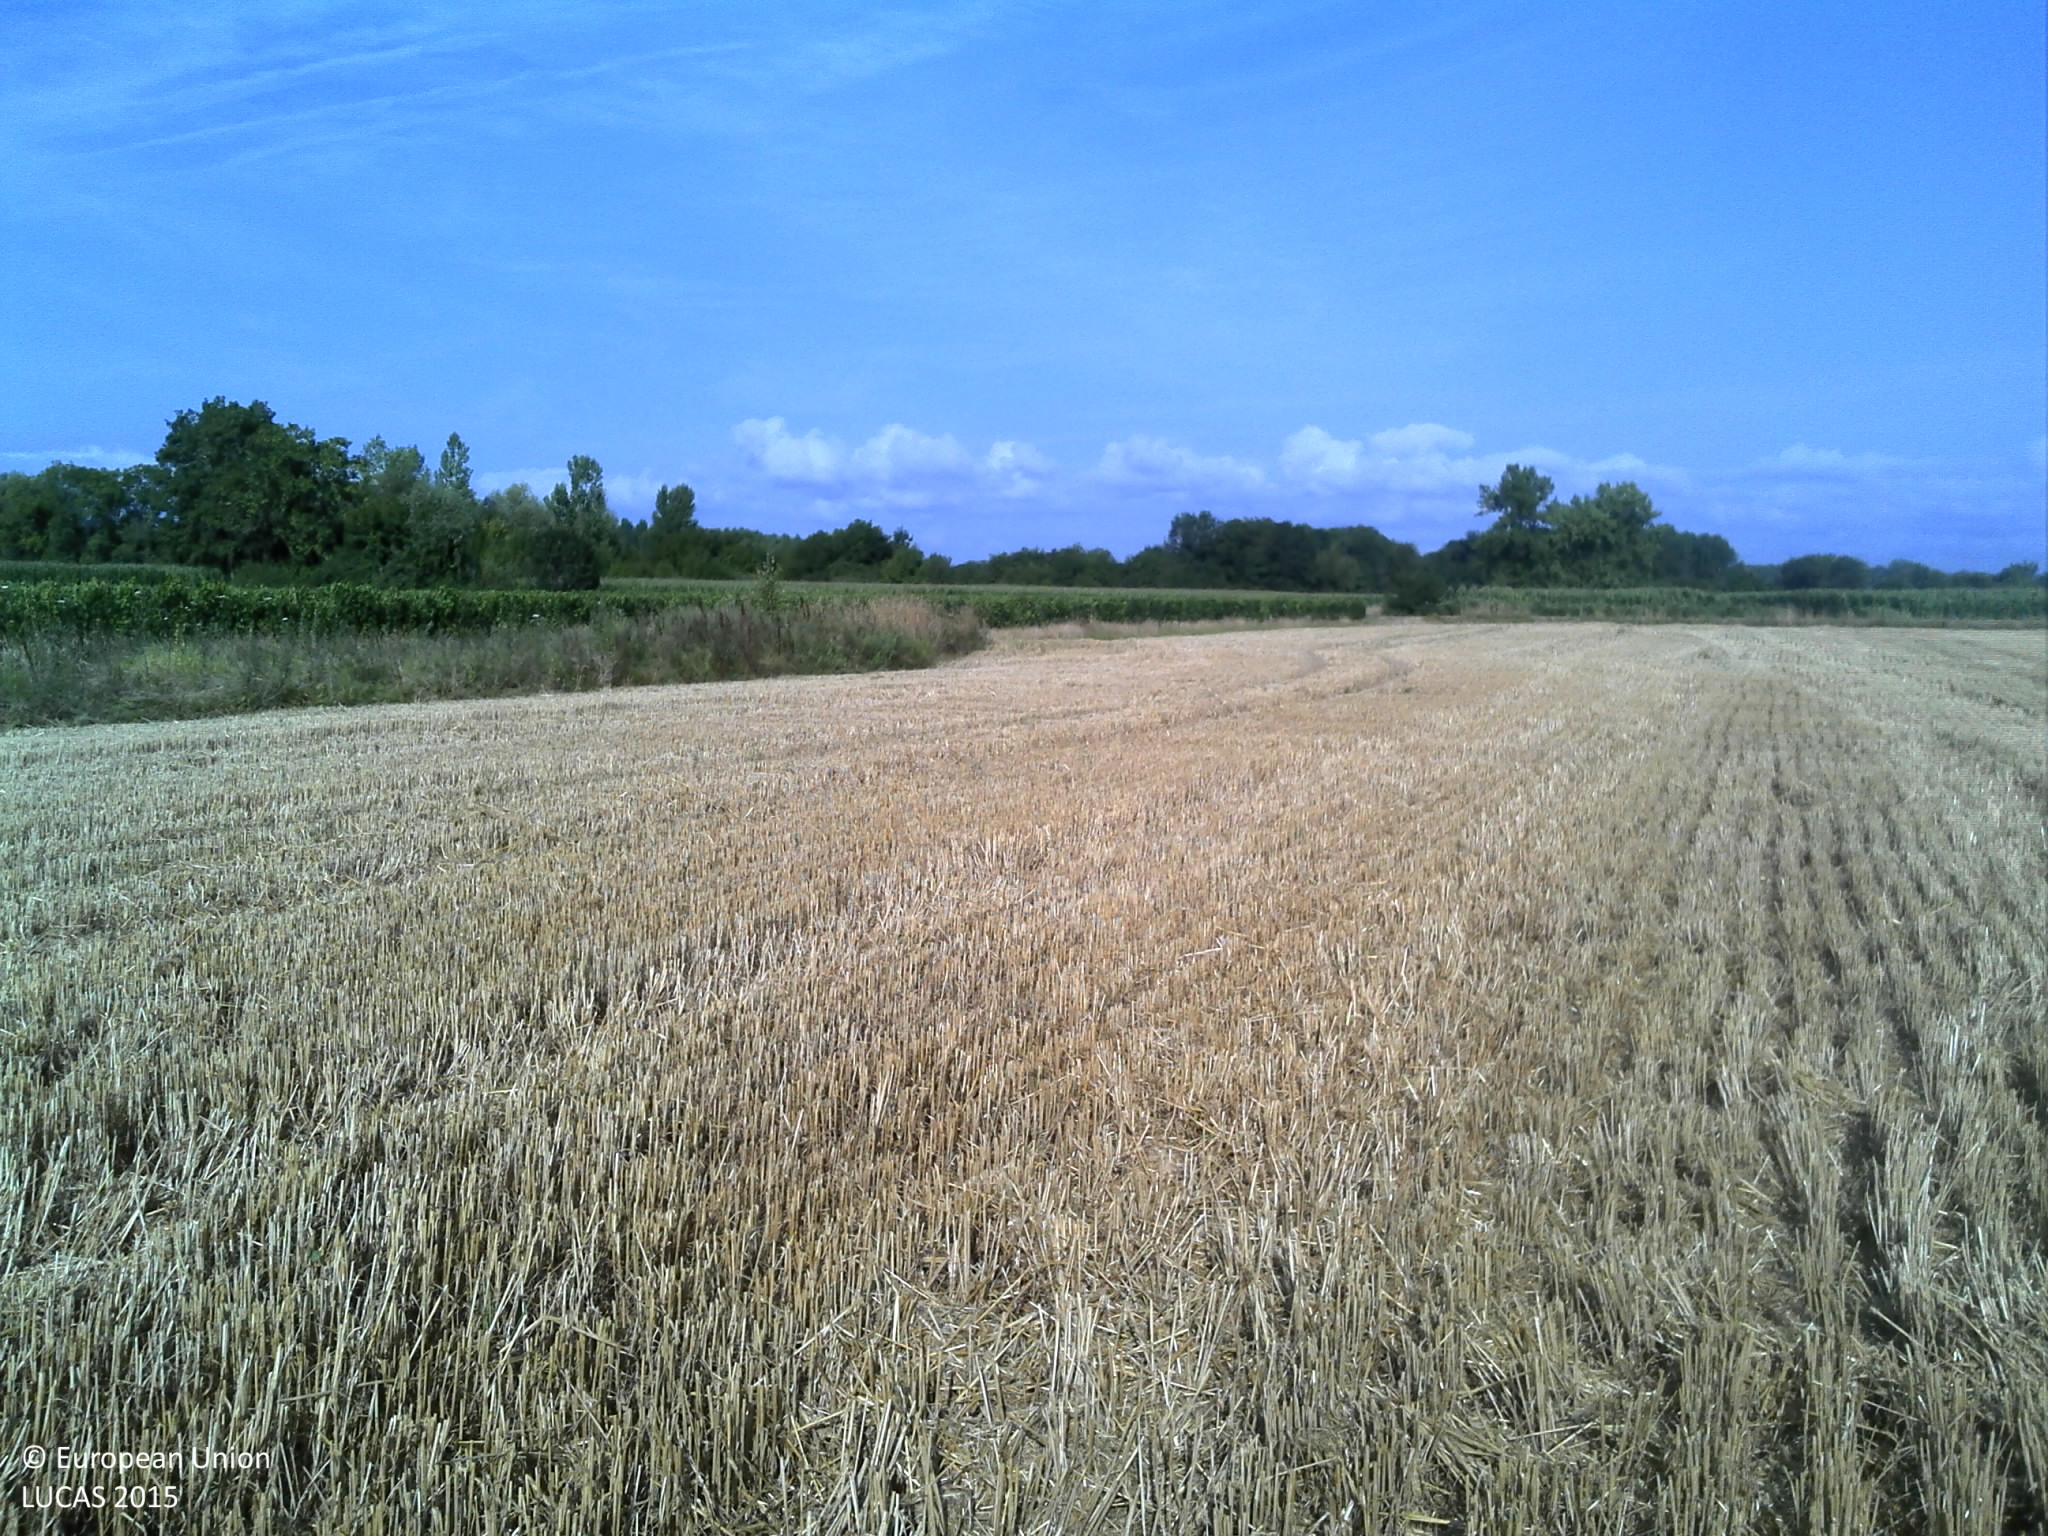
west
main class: Cropland
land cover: Common wheat
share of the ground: > 75 %
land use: Agriculture (excluding fallow land and kitchen gardens)
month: July
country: FR
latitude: 44.6985
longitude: -0.4023
